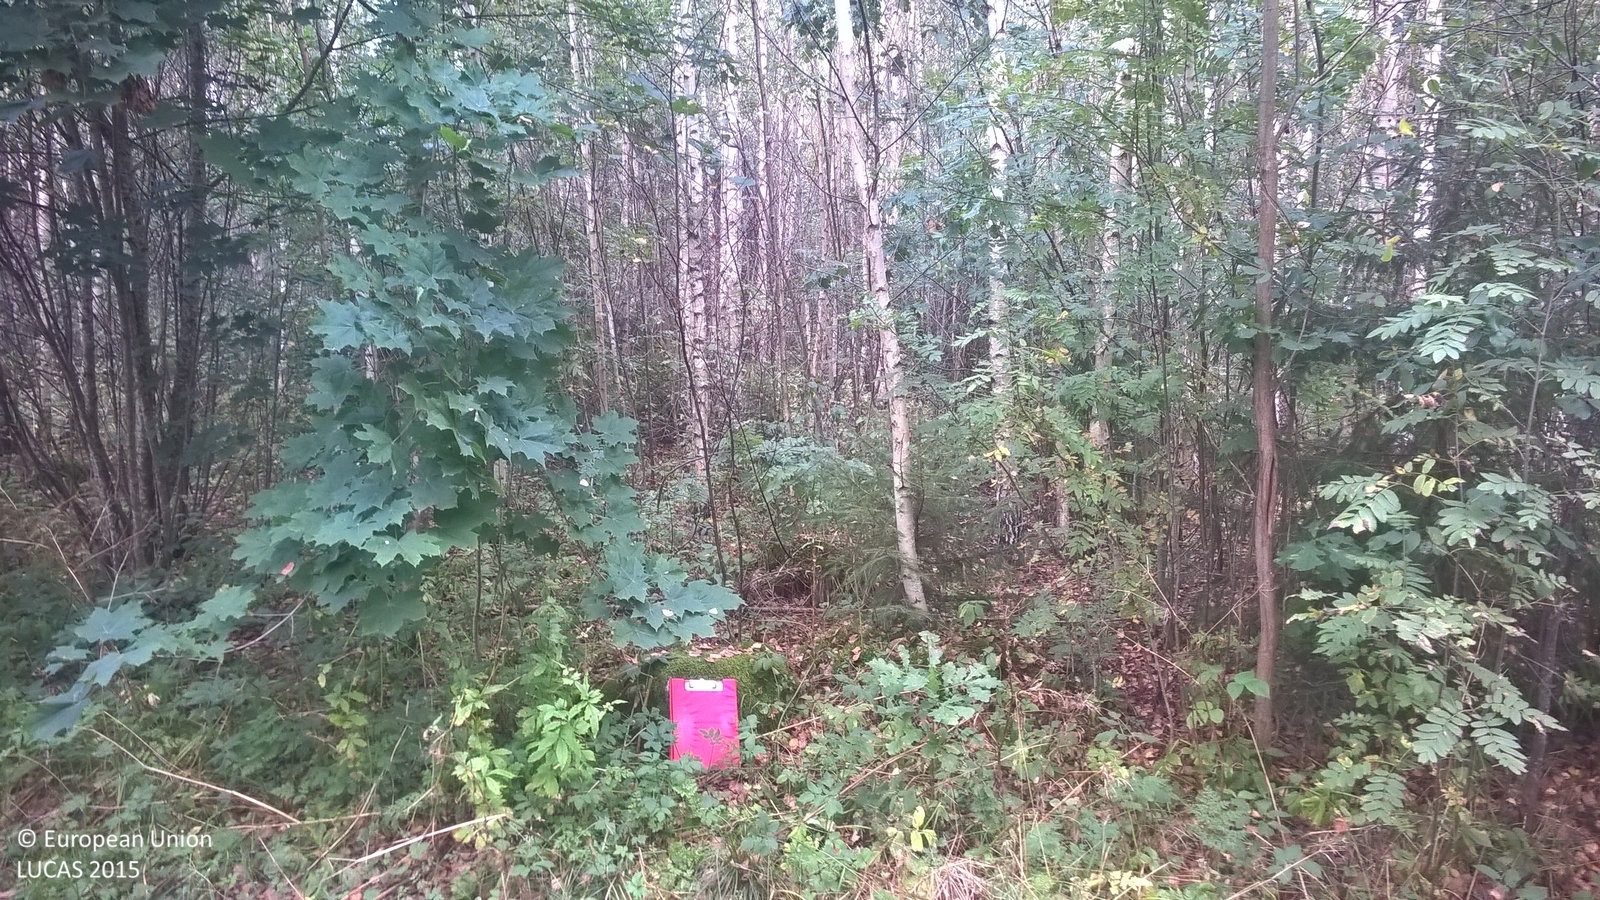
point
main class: Woodland
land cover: Broadleaved woodland
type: non-riverine alder, birch or aspen forest
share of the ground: > 75 %
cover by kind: broadleaved forest trees 85 %, herbaceous plants 10 %, shrubs 5 %
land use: Forestry
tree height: > 5 m
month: September
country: LV
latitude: 57.4841
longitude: 25.4425
